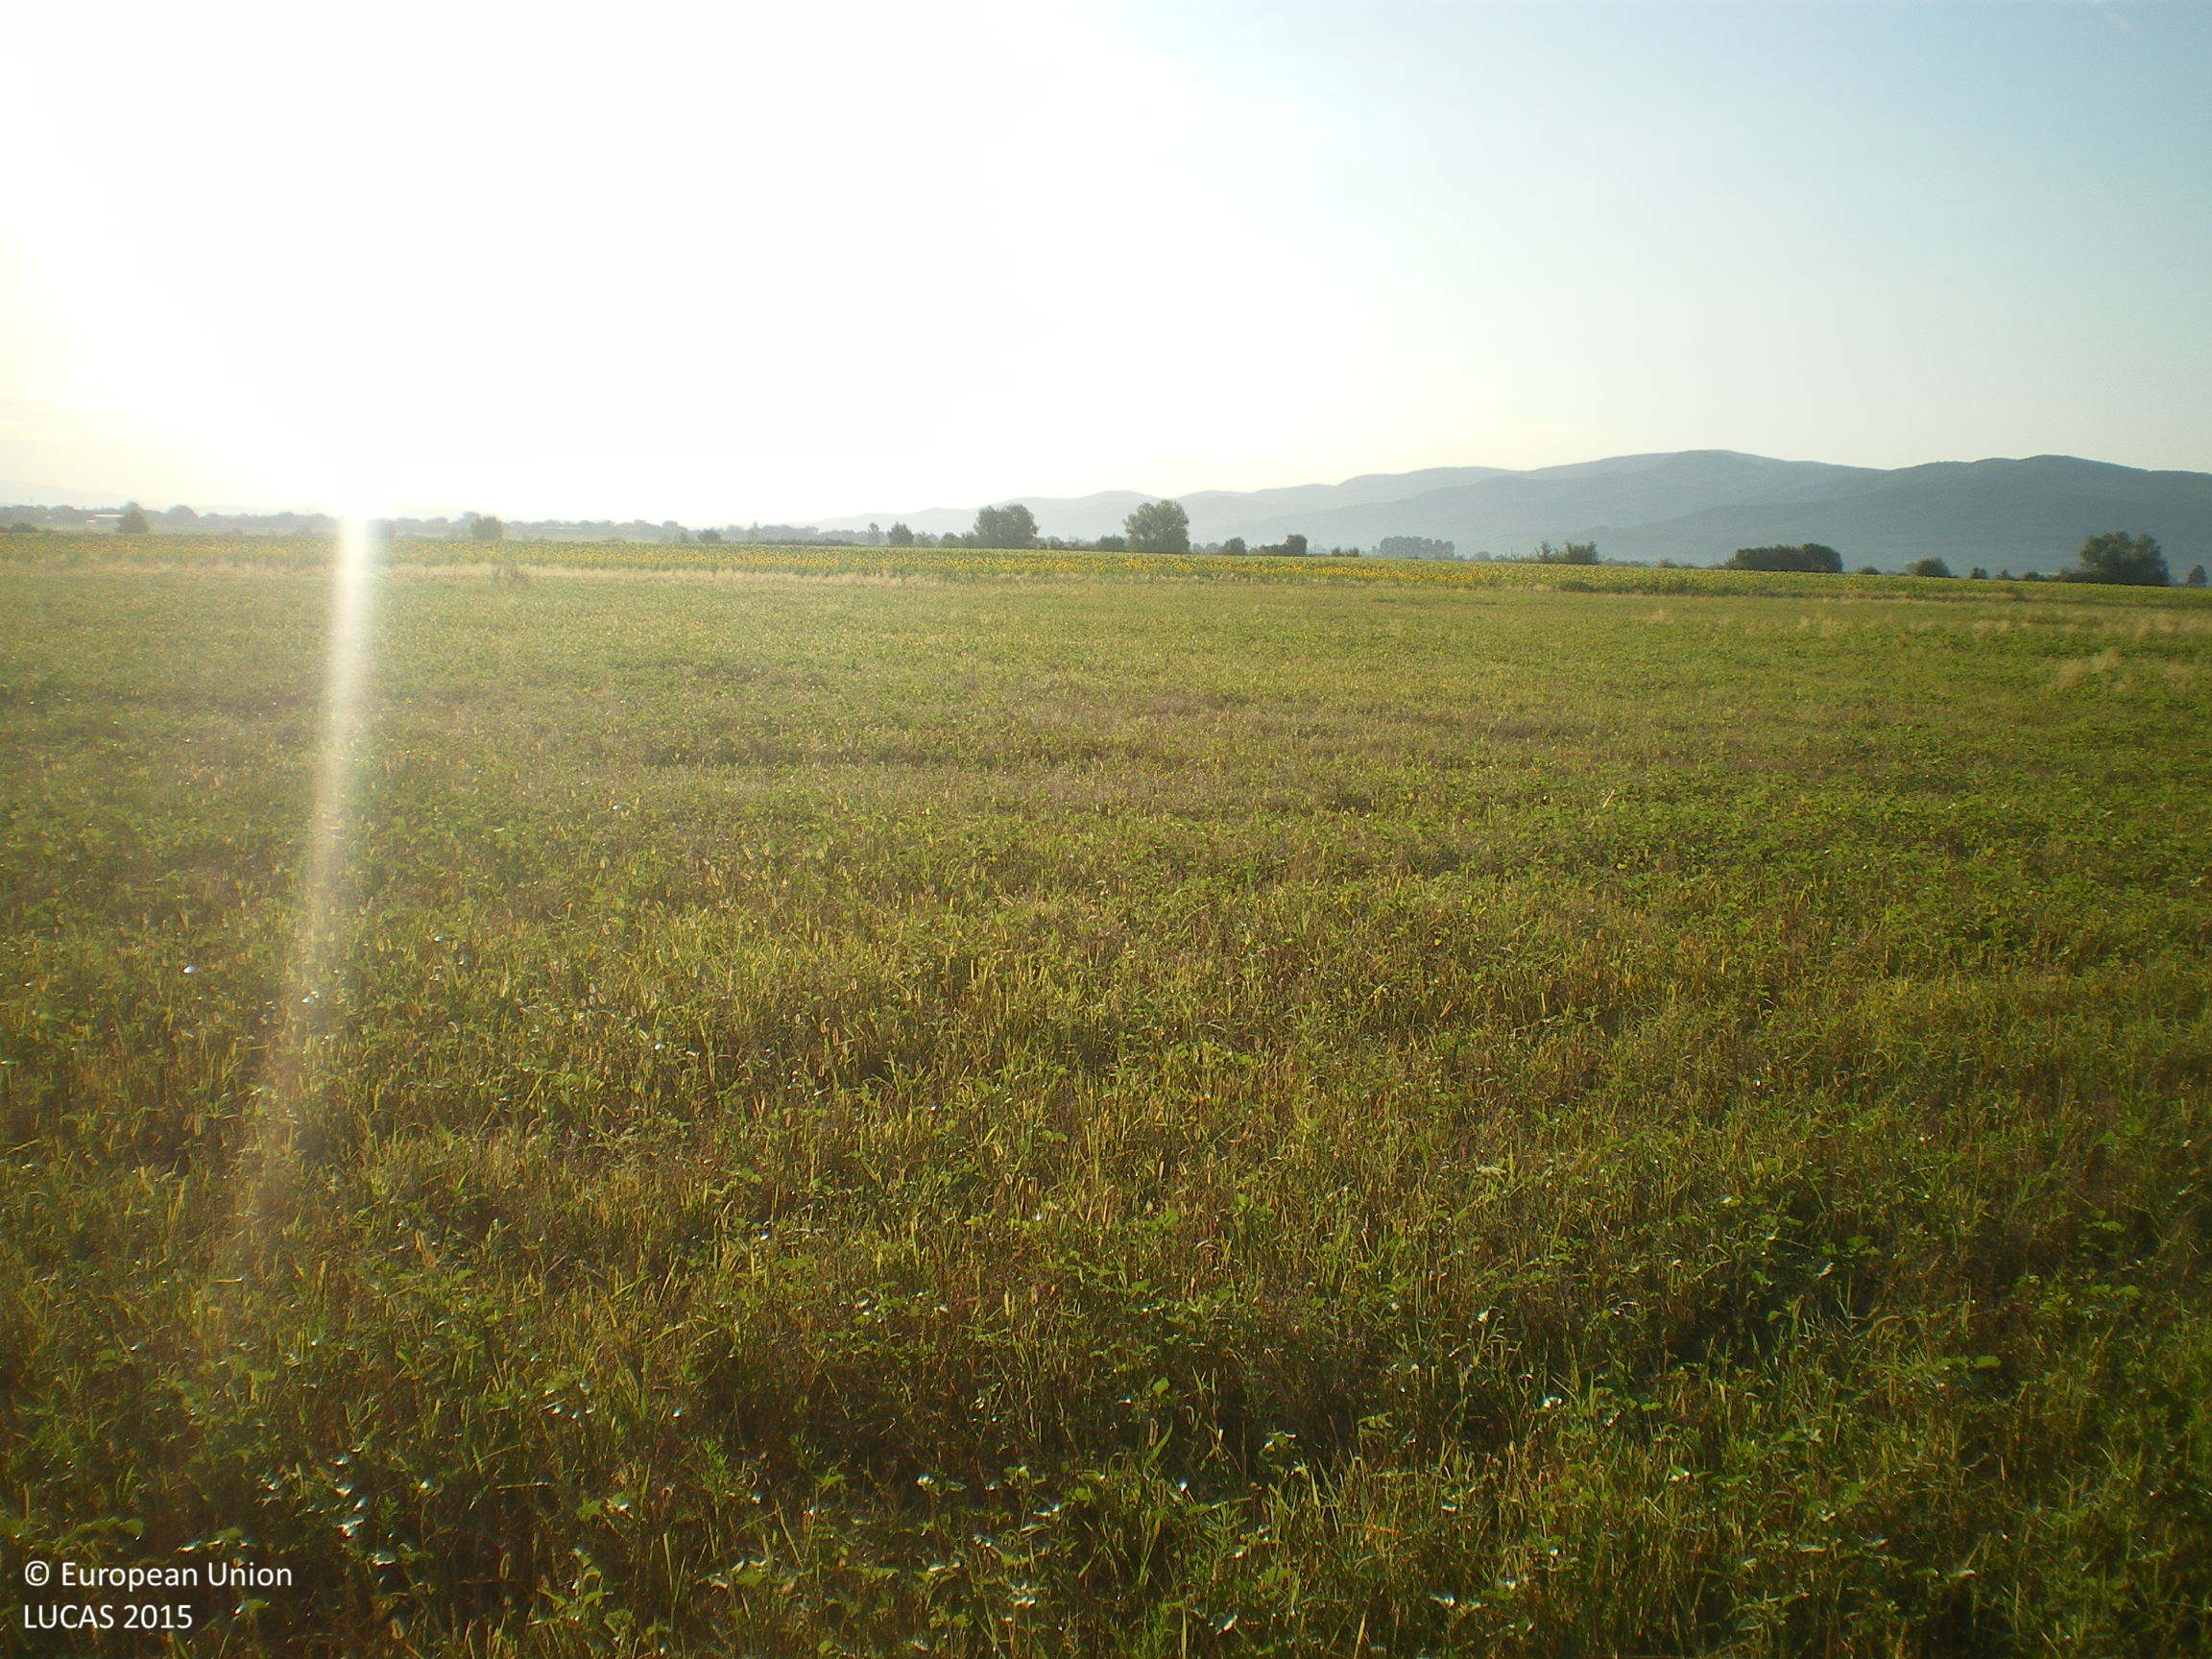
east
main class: Grassland
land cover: Spontaneously vegetated surfaces
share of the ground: > 75 %
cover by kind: herbaceous plants 100 %
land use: Fallow land
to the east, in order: Spontaneously vegetated surfaces; Sunflower
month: August
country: BG
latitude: 42.5914
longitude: 25.6111
